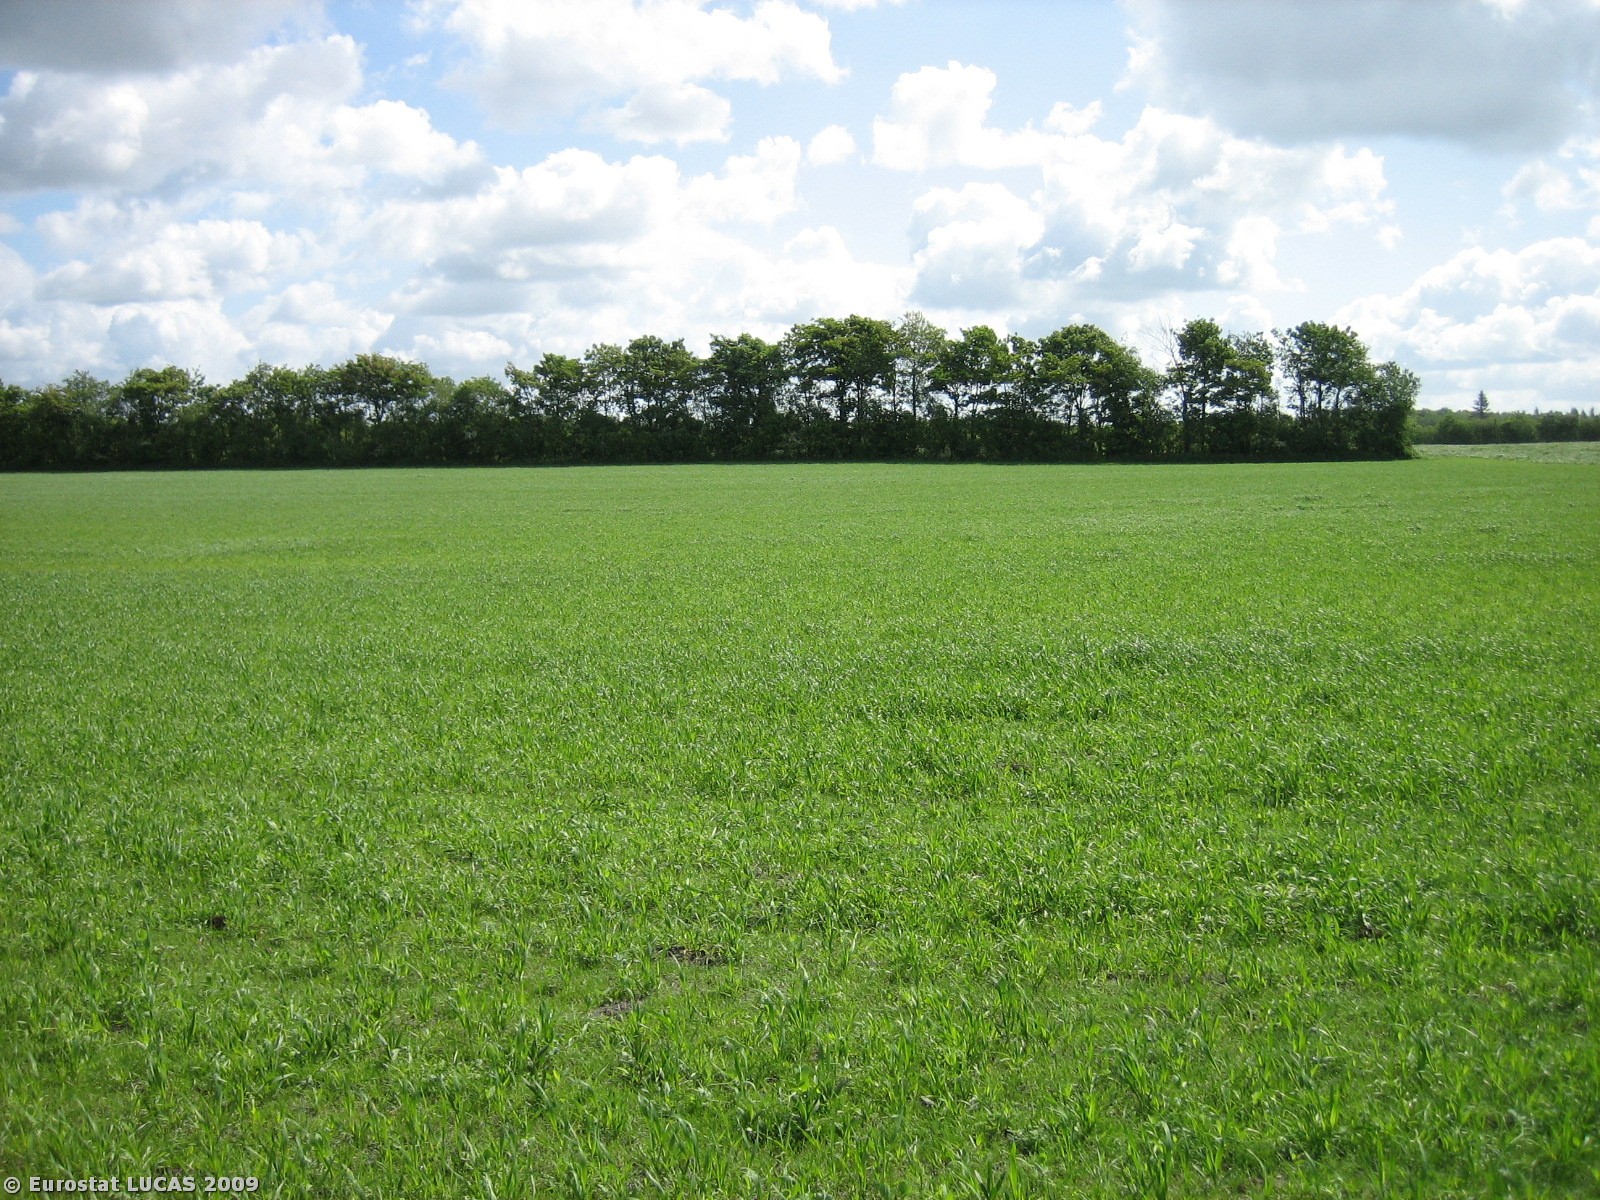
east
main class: Cropland
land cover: Rye
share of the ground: 25 - 50 %
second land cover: Dry pulses
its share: 10 - 25 %
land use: Agriculture (excluding fallow land and kitchen gardens)
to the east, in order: Rye; Dry pulses; Broadleaved woodland; Rye; Dry pulses
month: May
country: DK
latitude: 55.8442
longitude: 9.2821
